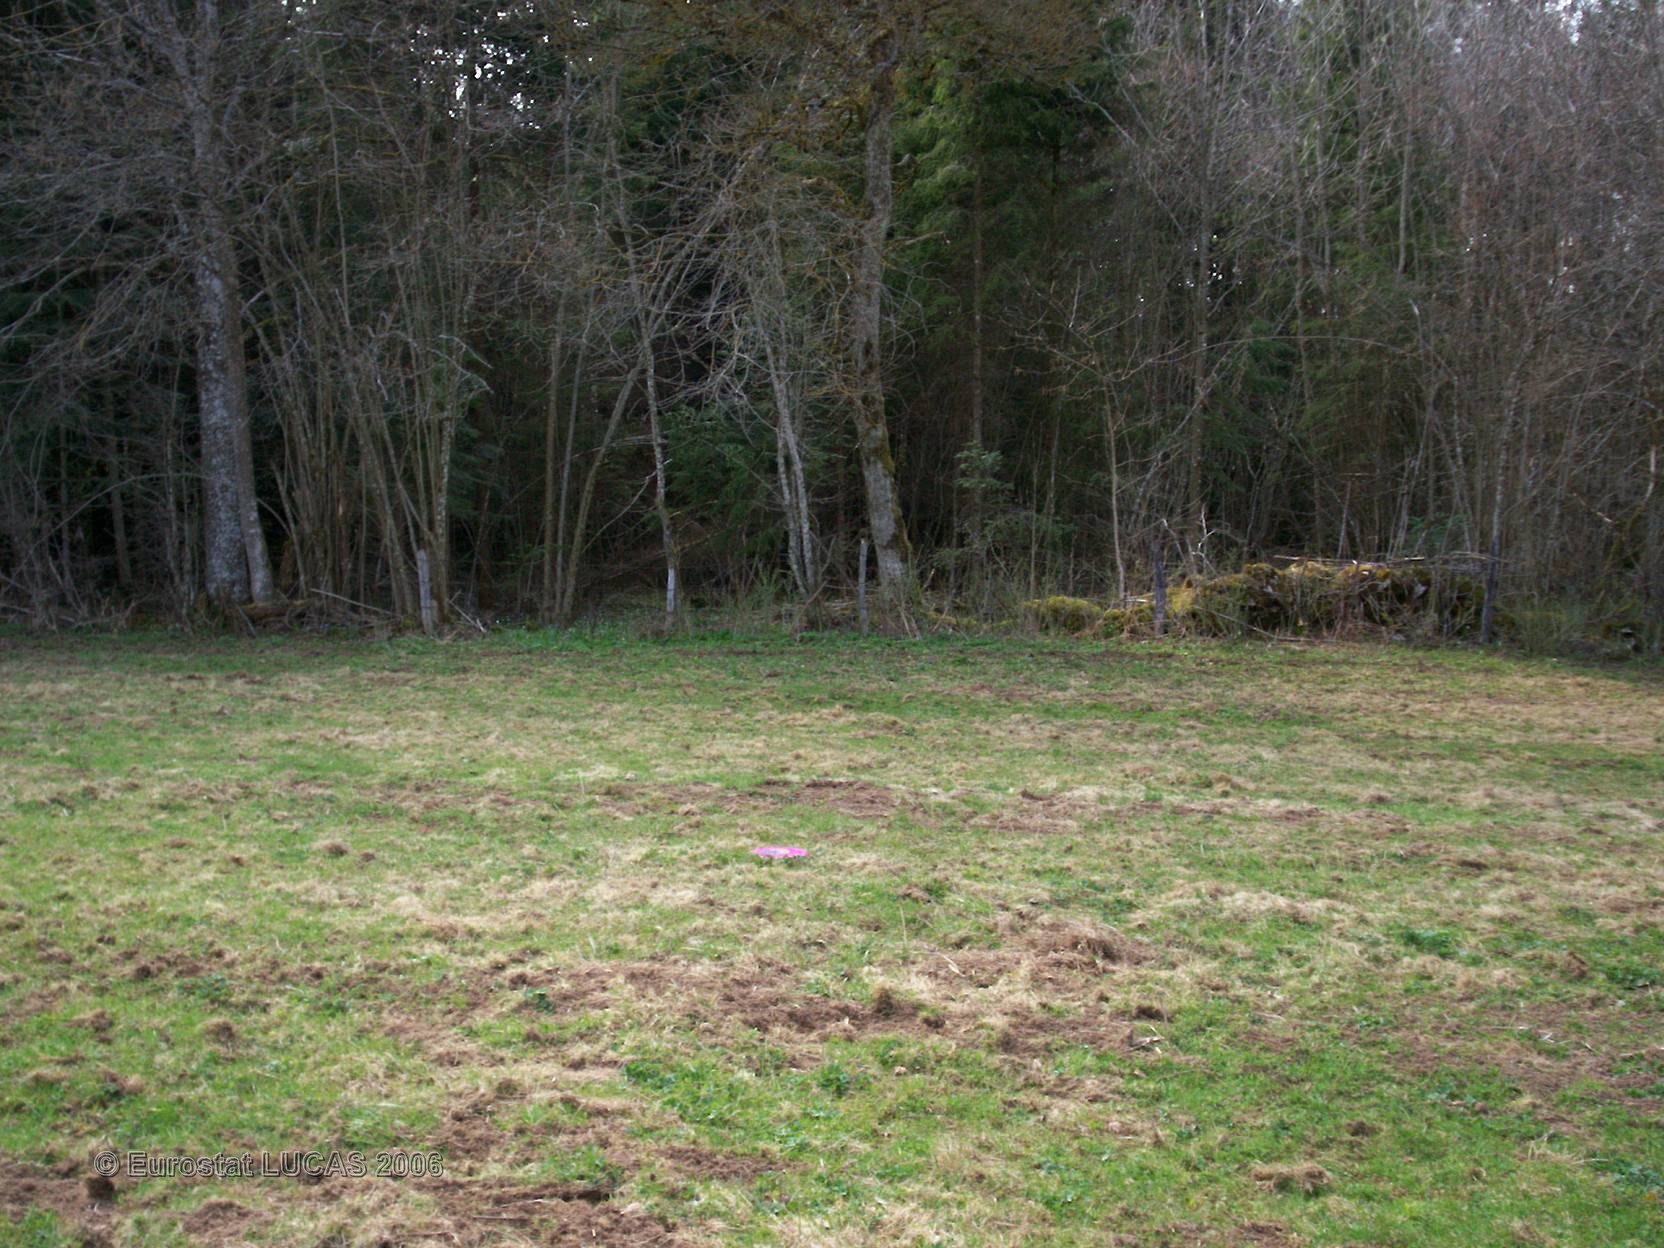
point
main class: Grassland
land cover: Grassland without tree/shrub cover
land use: Agriculture (excluding fallow land and kitchen gardens)
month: April
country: FR
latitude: 47.2526
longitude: 6.6061
